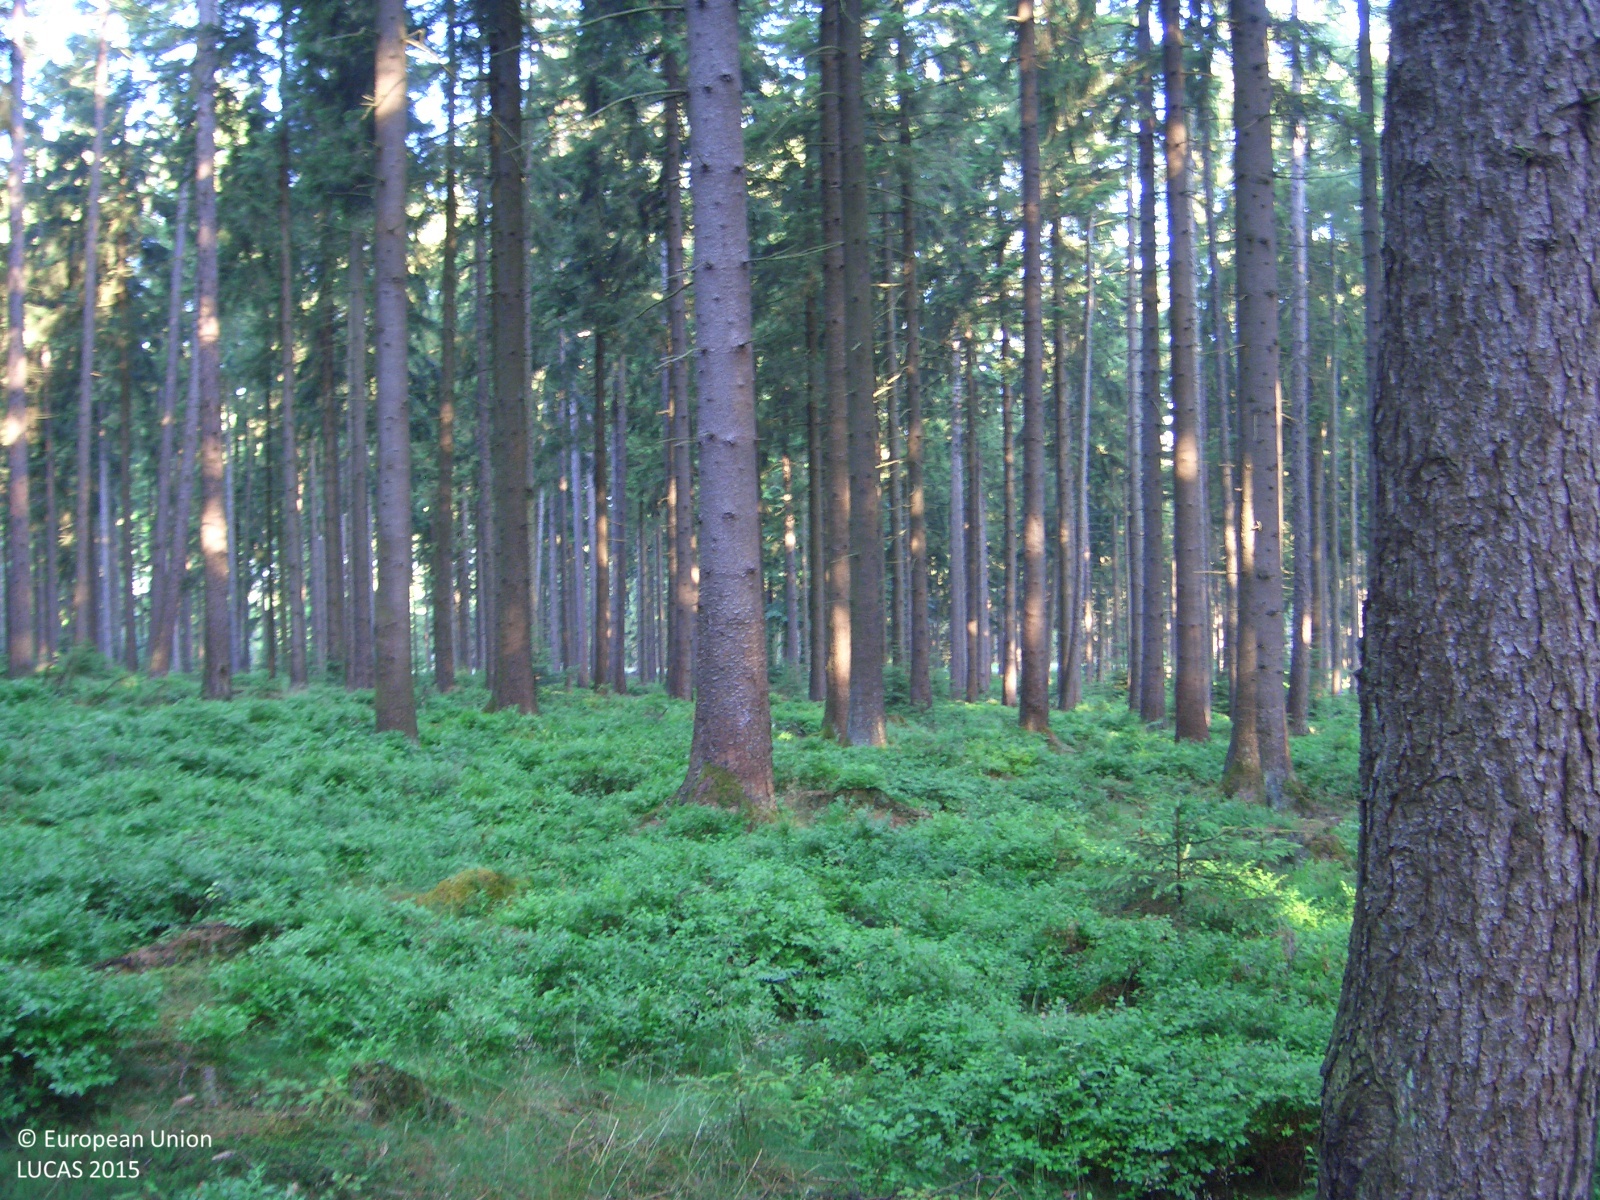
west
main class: Woodland
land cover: Spruce dominated coniferous woodland
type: hemiboreal forest and nemoral coniferous forest and mixed broadleaved-coniferous forest
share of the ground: 50 - 75 %
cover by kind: coniferous forest trees 80 %, herbaceous plants 20 %
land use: Forestry
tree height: > 5 m
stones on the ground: 25 - 50 %
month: July
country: DE
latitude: 50.6626
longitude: 6.2503
